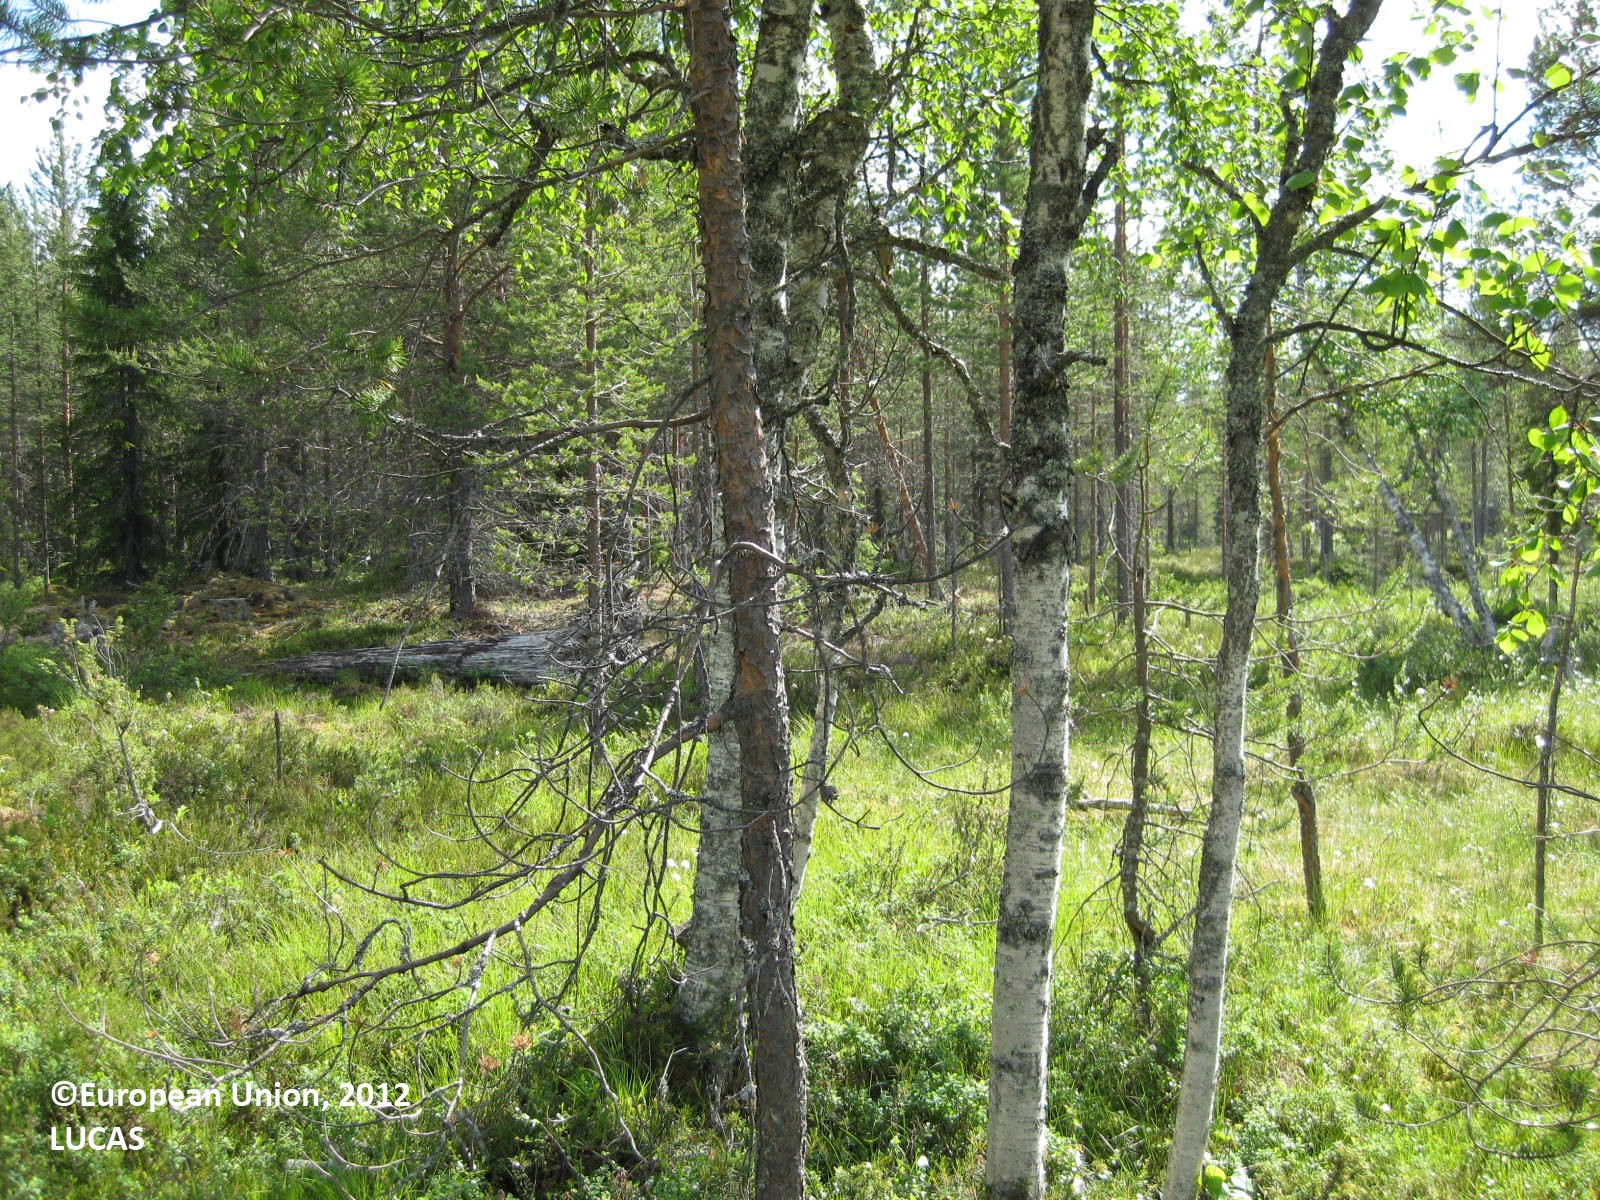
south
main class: Woodland
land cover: Pine dominated coniferous woodland
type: boreal forest
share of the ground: 50 - 75 %
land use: Forestry
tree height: > 5 m
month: July
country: FI
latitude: 65.5223
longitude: 29.4238
